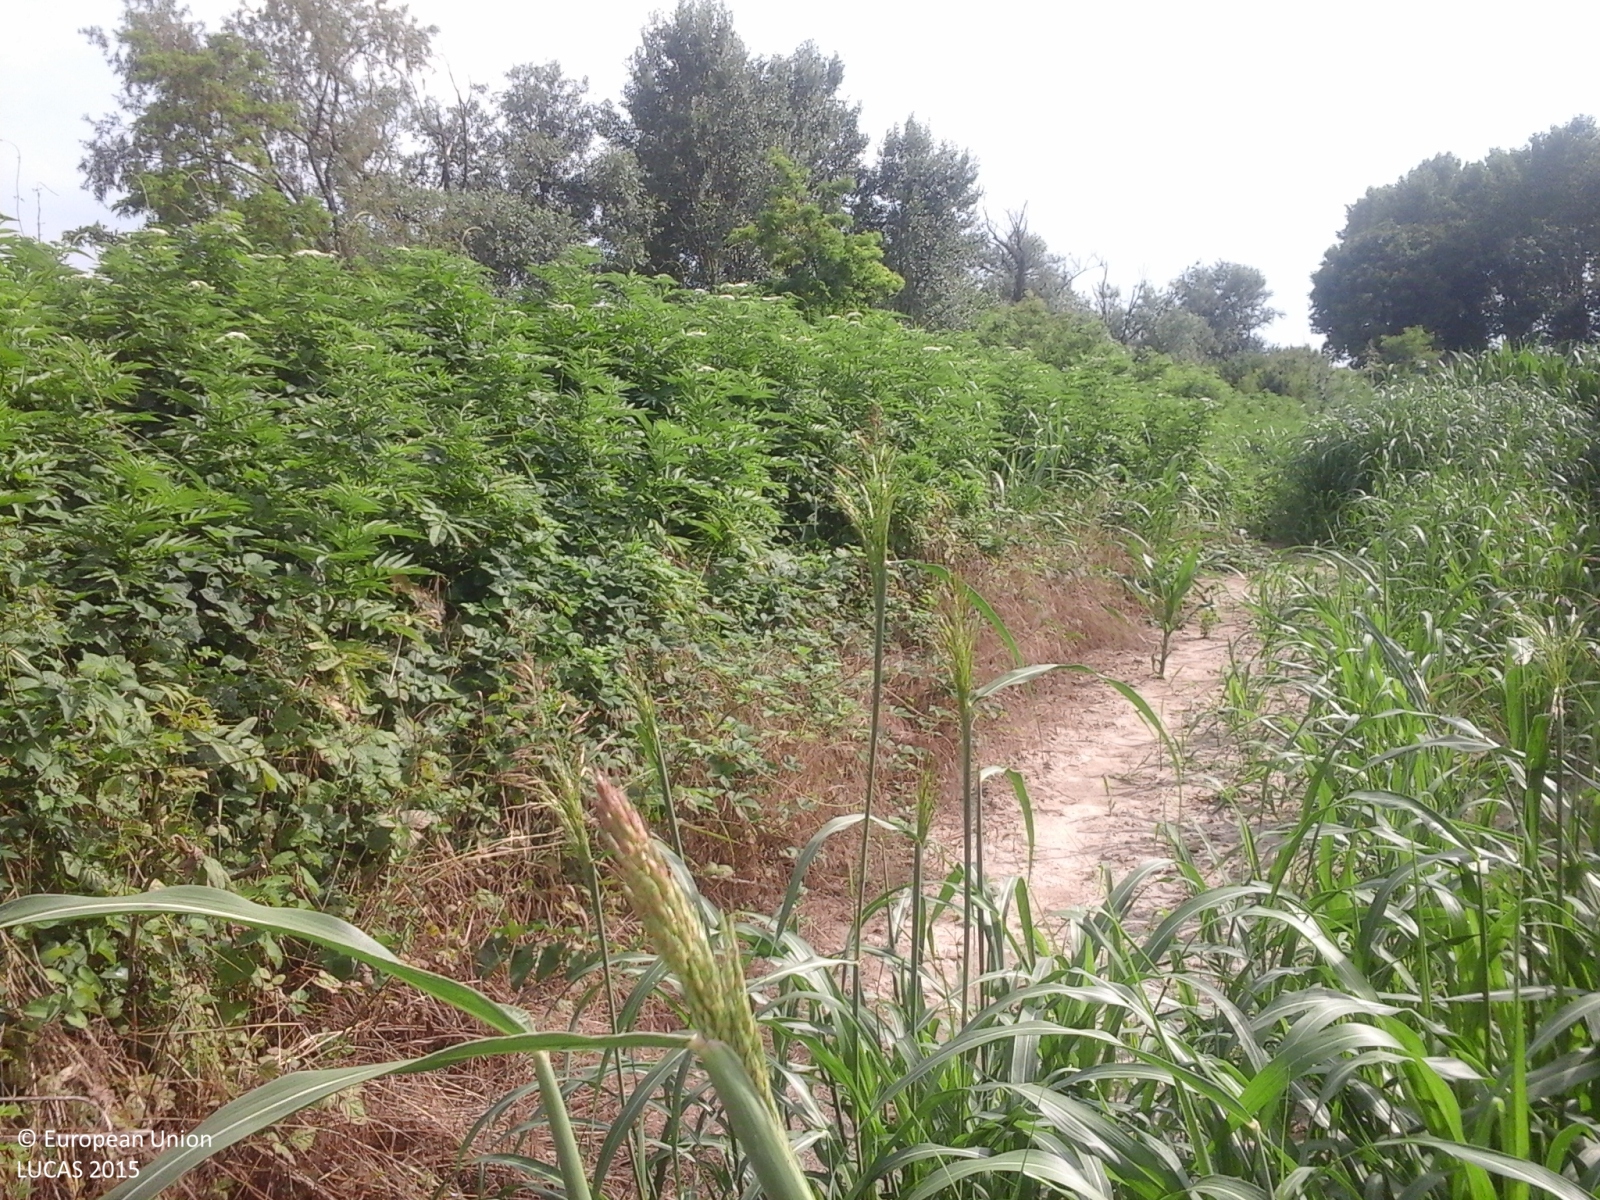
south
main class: Cropland
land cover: Maize
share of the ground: > 75 %
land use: Agriculture (excluding fallow land and kitchen gardens)
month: June
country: IT
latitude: 45.0289
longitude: 8.7965
